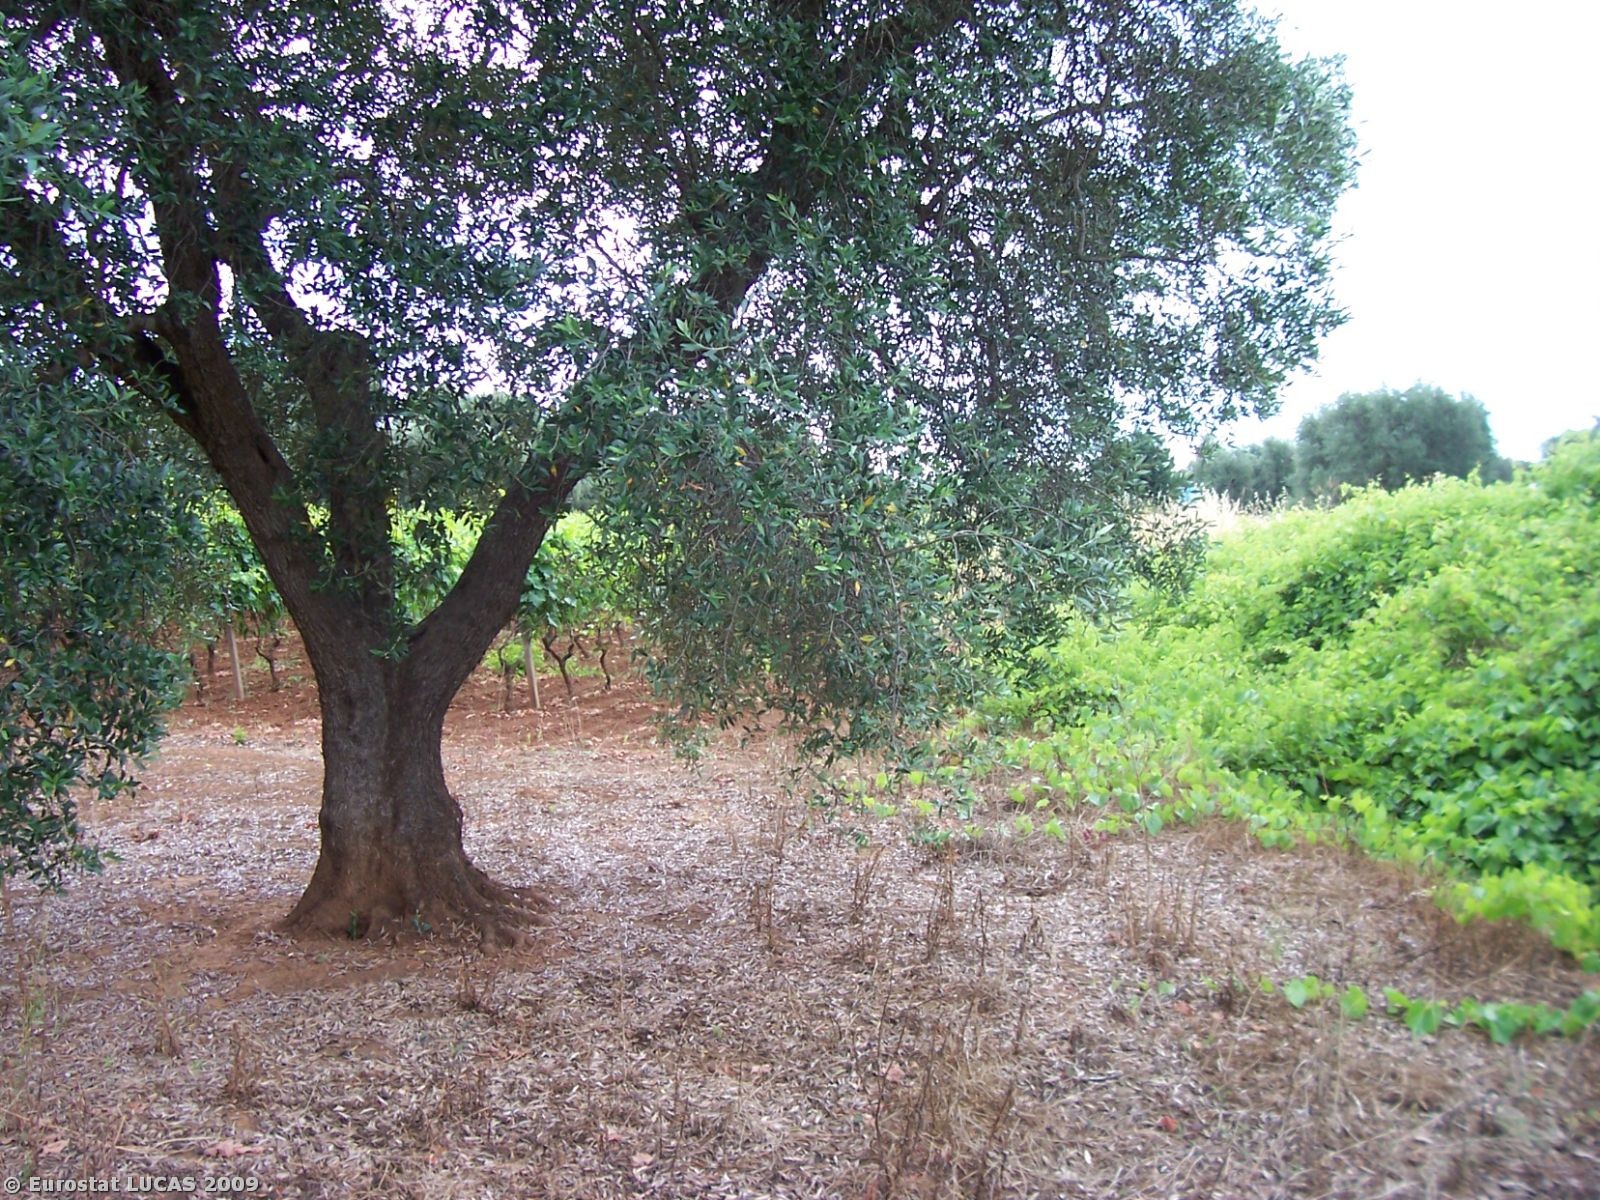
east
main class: Cropland
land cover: Olive groves
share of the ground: 25 - 50 %
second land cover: Spontaneously vegetated surfaces
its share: > 75 %
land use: Agriculture (excluding fallow land and kitchen gardens)
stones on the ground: < 10 %
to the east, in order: Olive groves; Spontaneously vegetated surfaces; Vineyards; Bare land; Ditches and canals; Shruby margins; Paved roads, cycling and walking lanes; Shruby margins; Electric lines; Ditches and canals
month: June
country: IT
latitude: 40.3615
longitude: 17.4995
